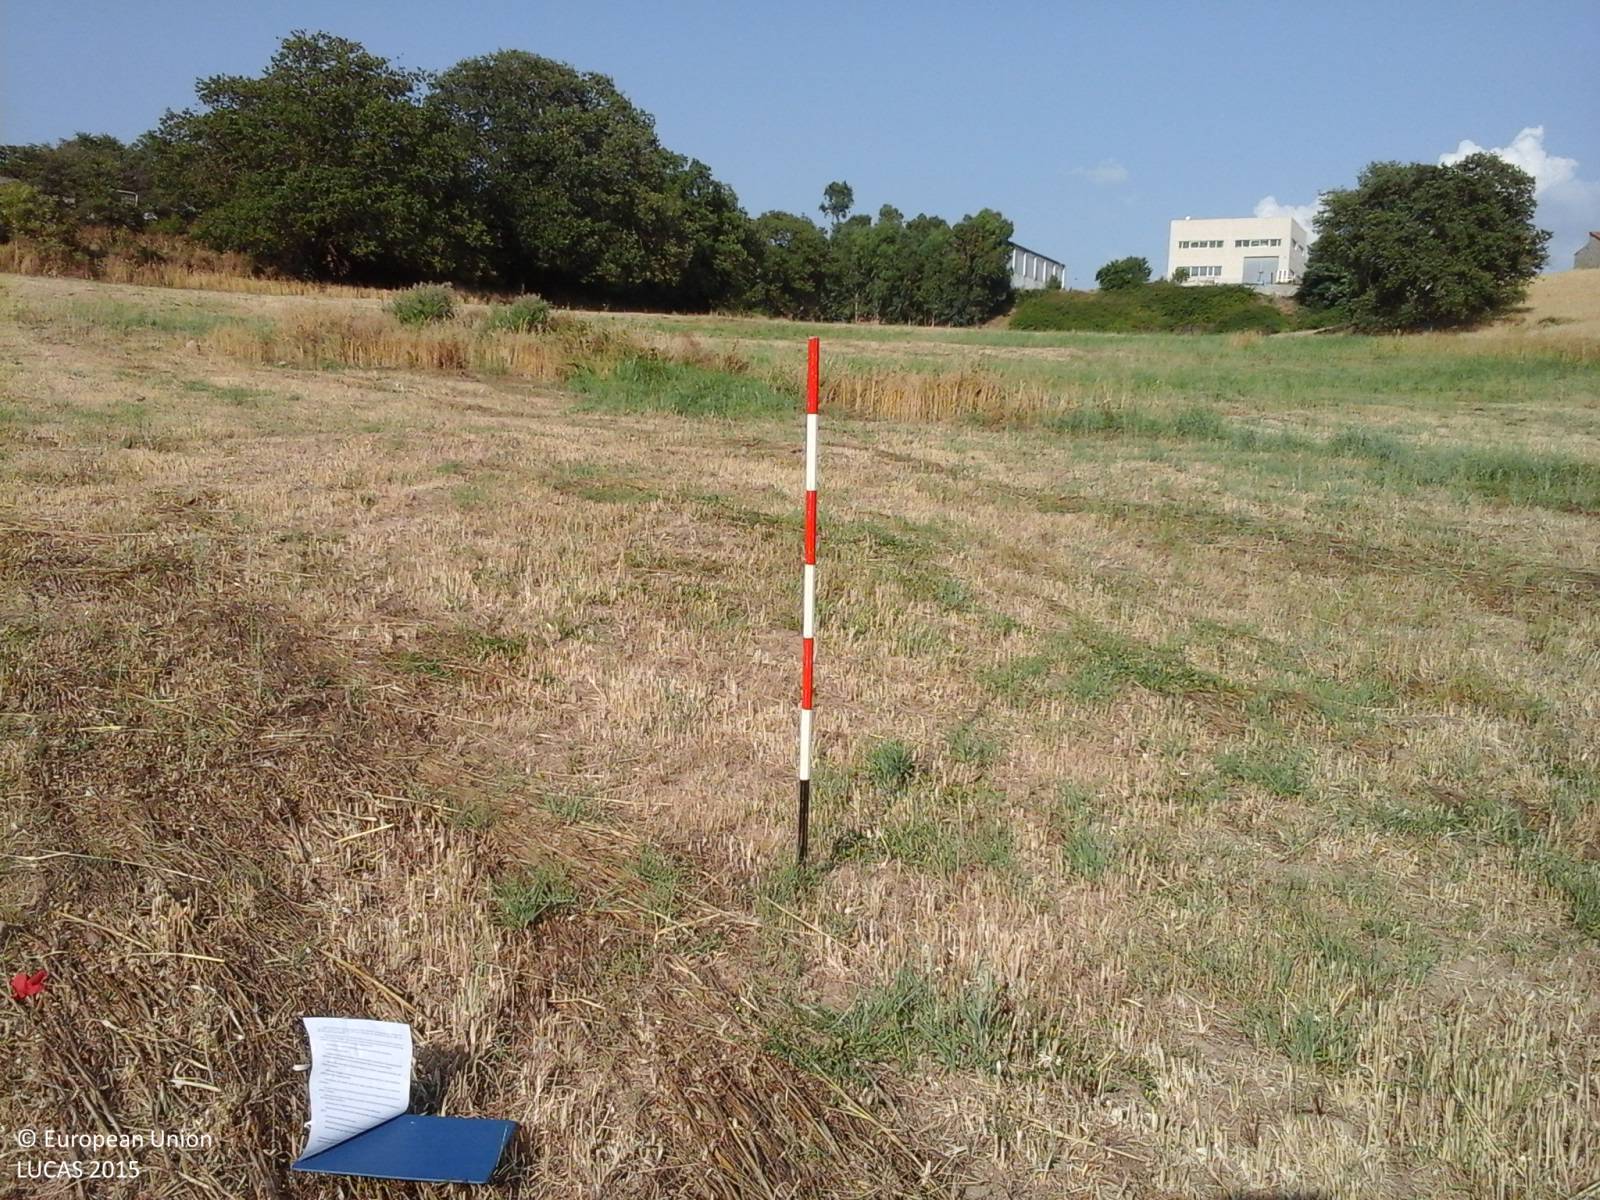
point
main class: Cropland
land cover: Oats
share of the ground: > 75 %
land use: Agriculture (excluding fallow land and kitchen gardens)
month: July
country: IT
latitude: 40.0267
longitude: 8.9861
